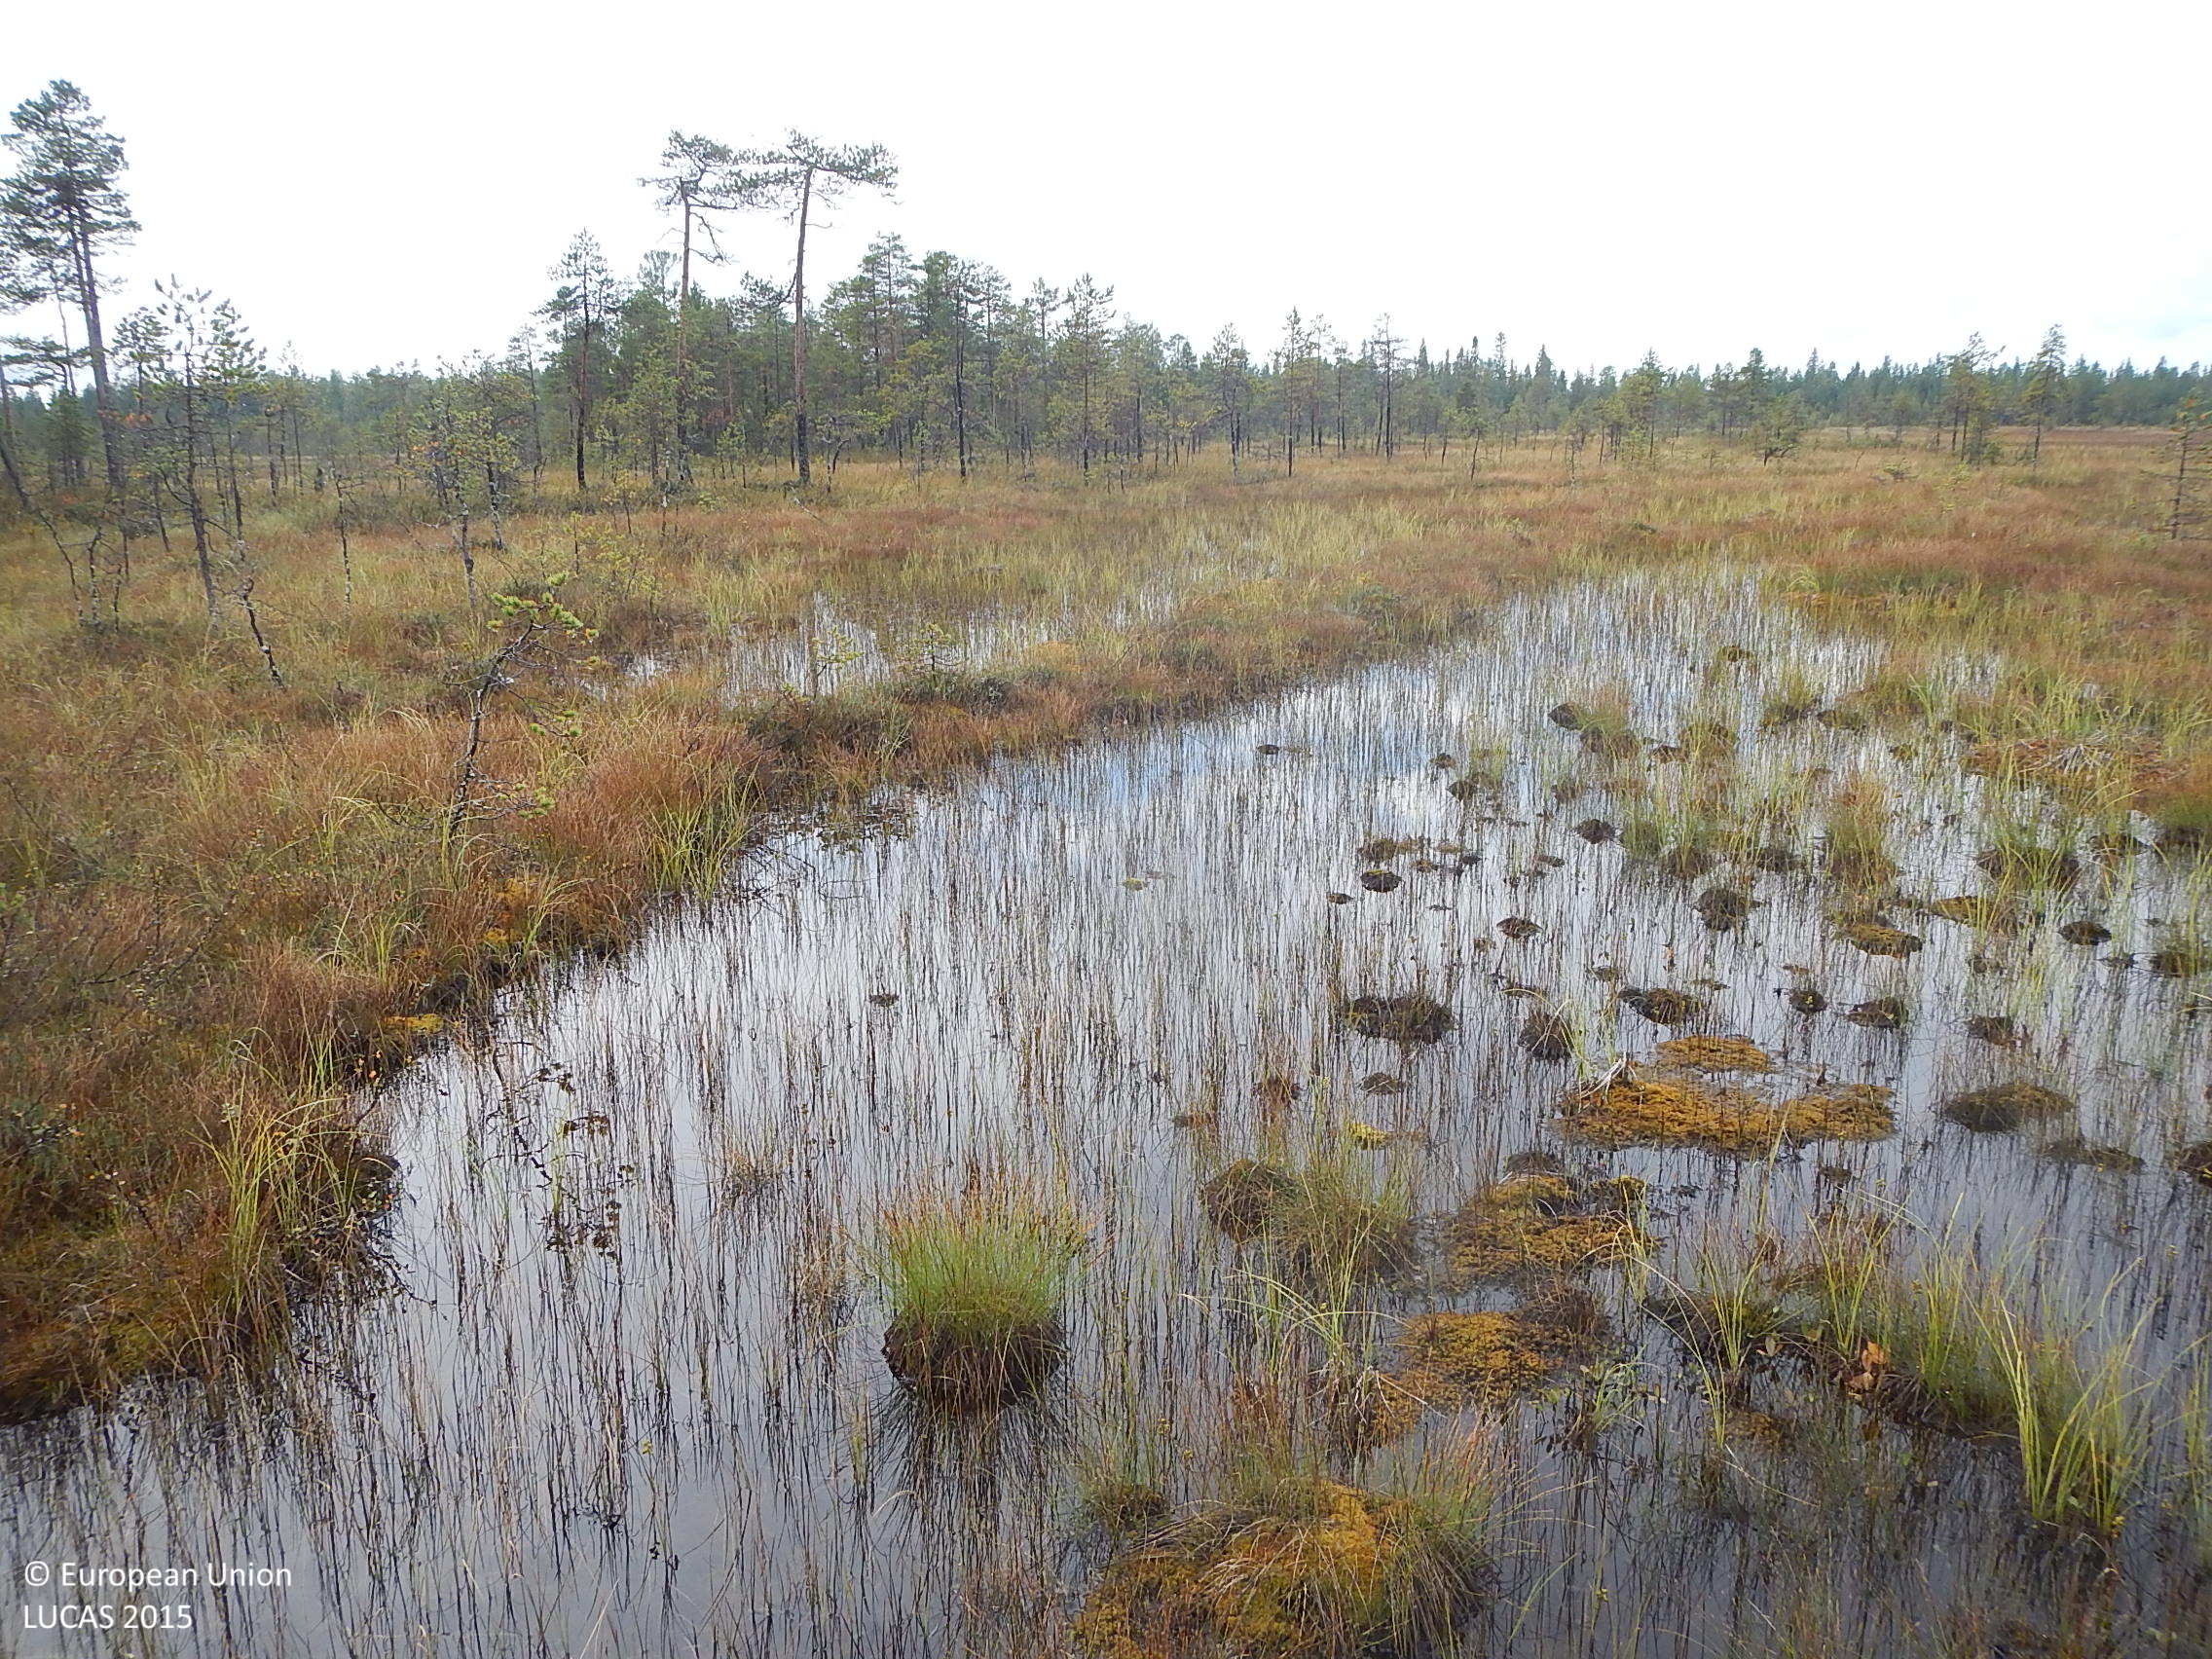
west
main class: Woodland
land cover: Pine dominated coniferous woodland
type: mire and swamp forests
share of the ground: 10 - 25 %
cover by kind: lichens and mosses 60 %, herbaceous plants 25 %, coniferous forest trees 15 %
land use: Semi-natural and natural areas not in use
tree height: < 5 m
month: August
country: FI
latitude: 65.6717
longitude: 27.1053
